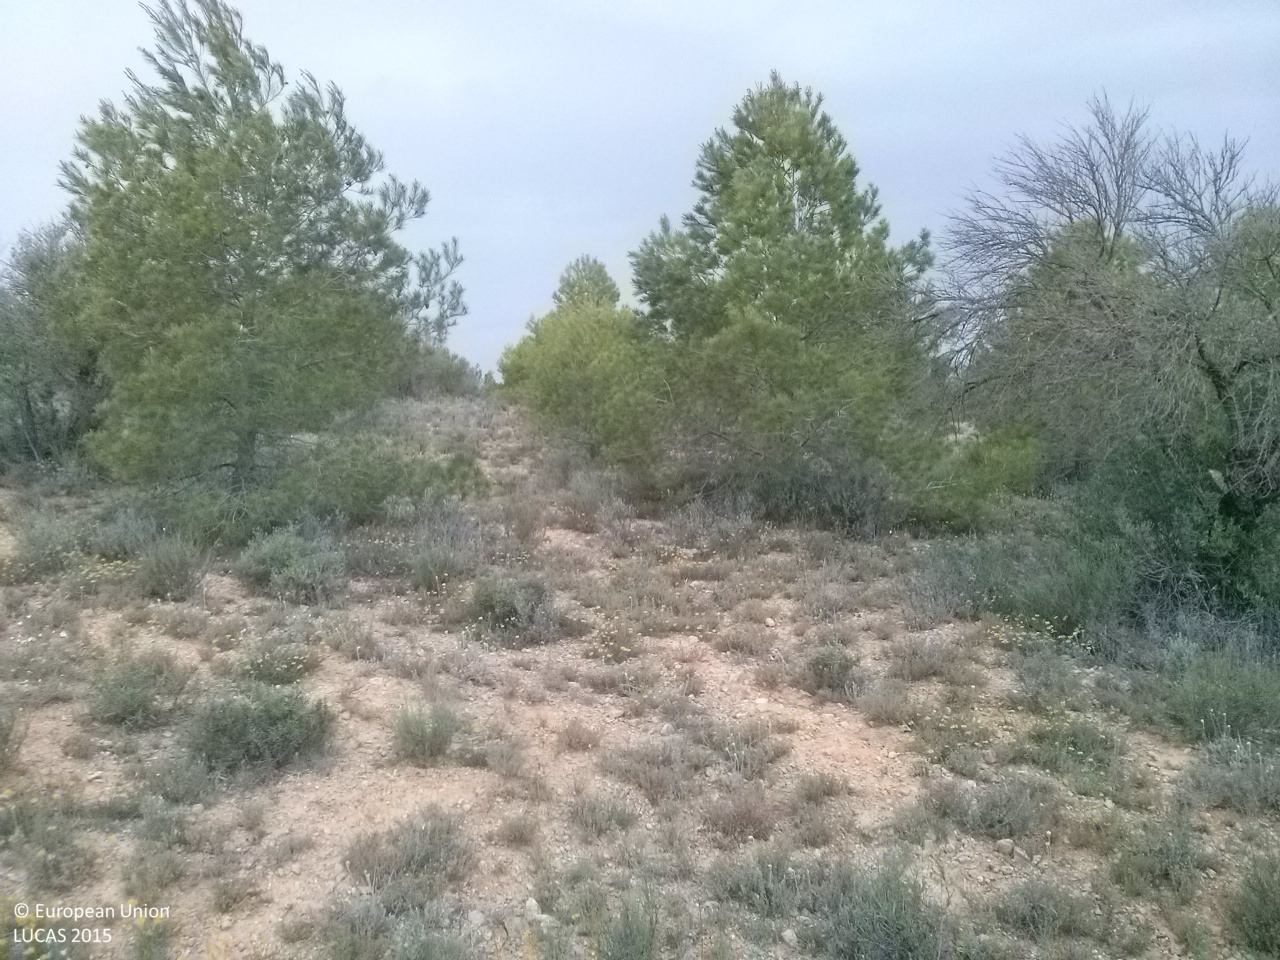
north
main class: Woodland
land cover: Pine dominated mixed woodland
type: coniferous forest of the mediterranean region
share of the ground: 10 - 25 %
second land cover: Shrubland without tree cover
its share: 50 - 75 %
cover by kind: shrubs 30 %, unconsolidated bare surface 25 %, herbaceous plants 20 %, coniferous forest trees 15 %, broadleaved forest trees 10 %
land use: Forestry
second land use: Agriculture (excluding fallow land and kitchen gardens)
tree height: > 5 m
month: May
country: ES
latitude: 39.9802
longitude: -2.8913
